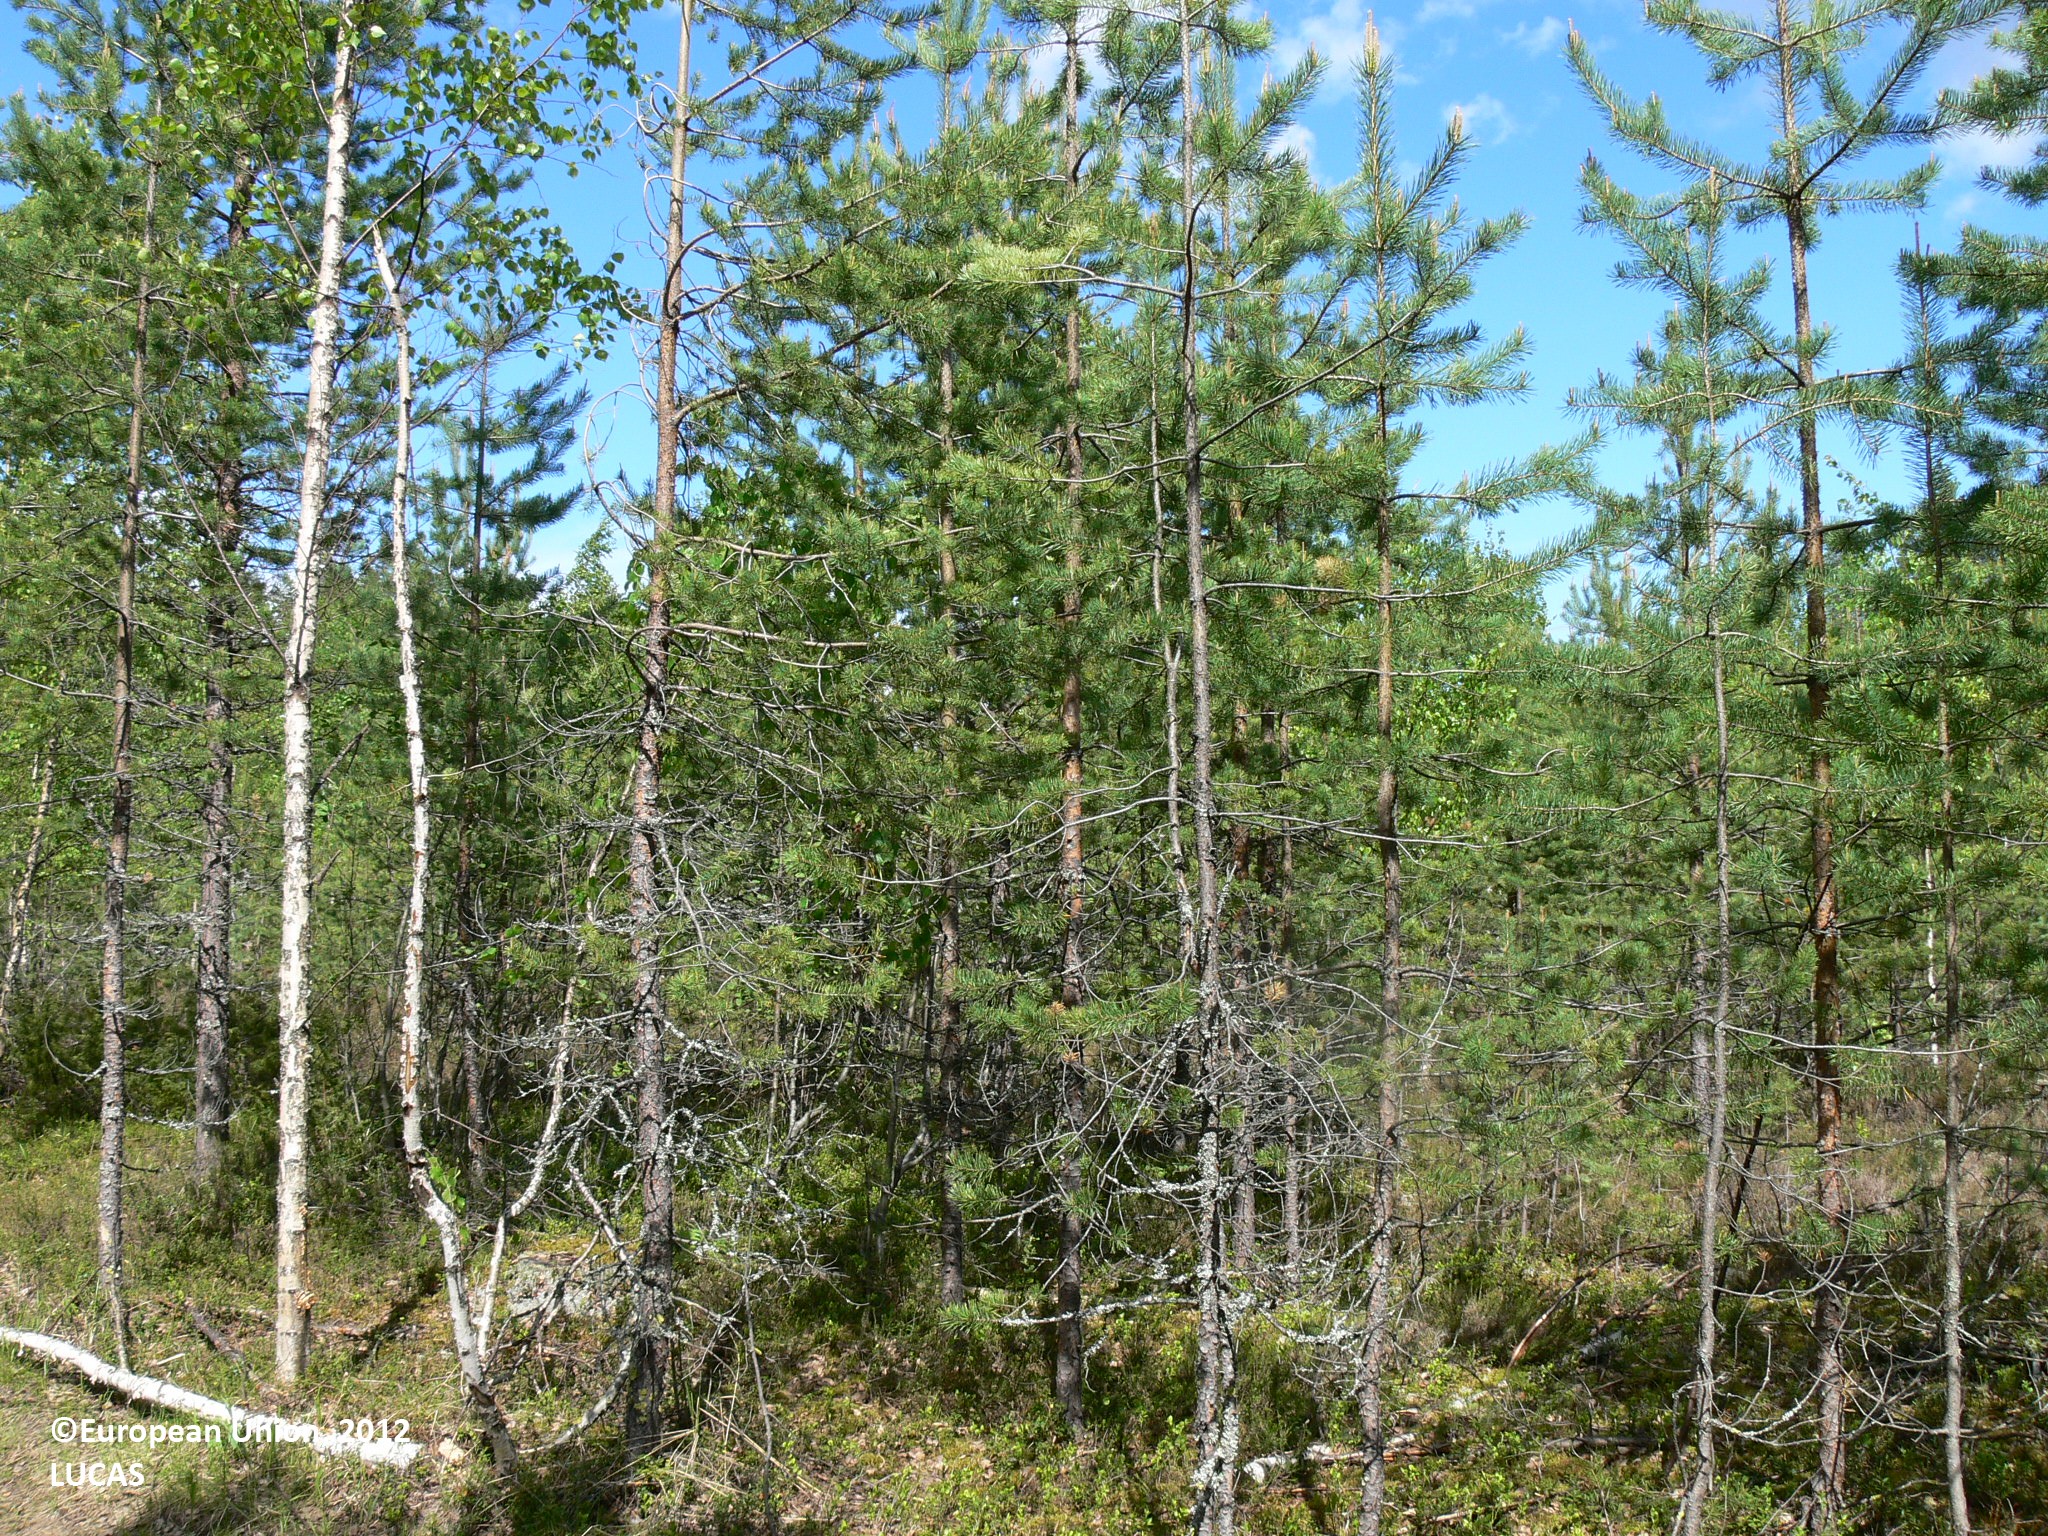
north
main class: Woodland
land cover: Pine dominated mixed woodland
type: boreal forest
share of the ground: > 75 %
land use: Forestry
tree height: < 5 m
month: June
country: FI
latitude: 62.6834
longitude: 29.7611
